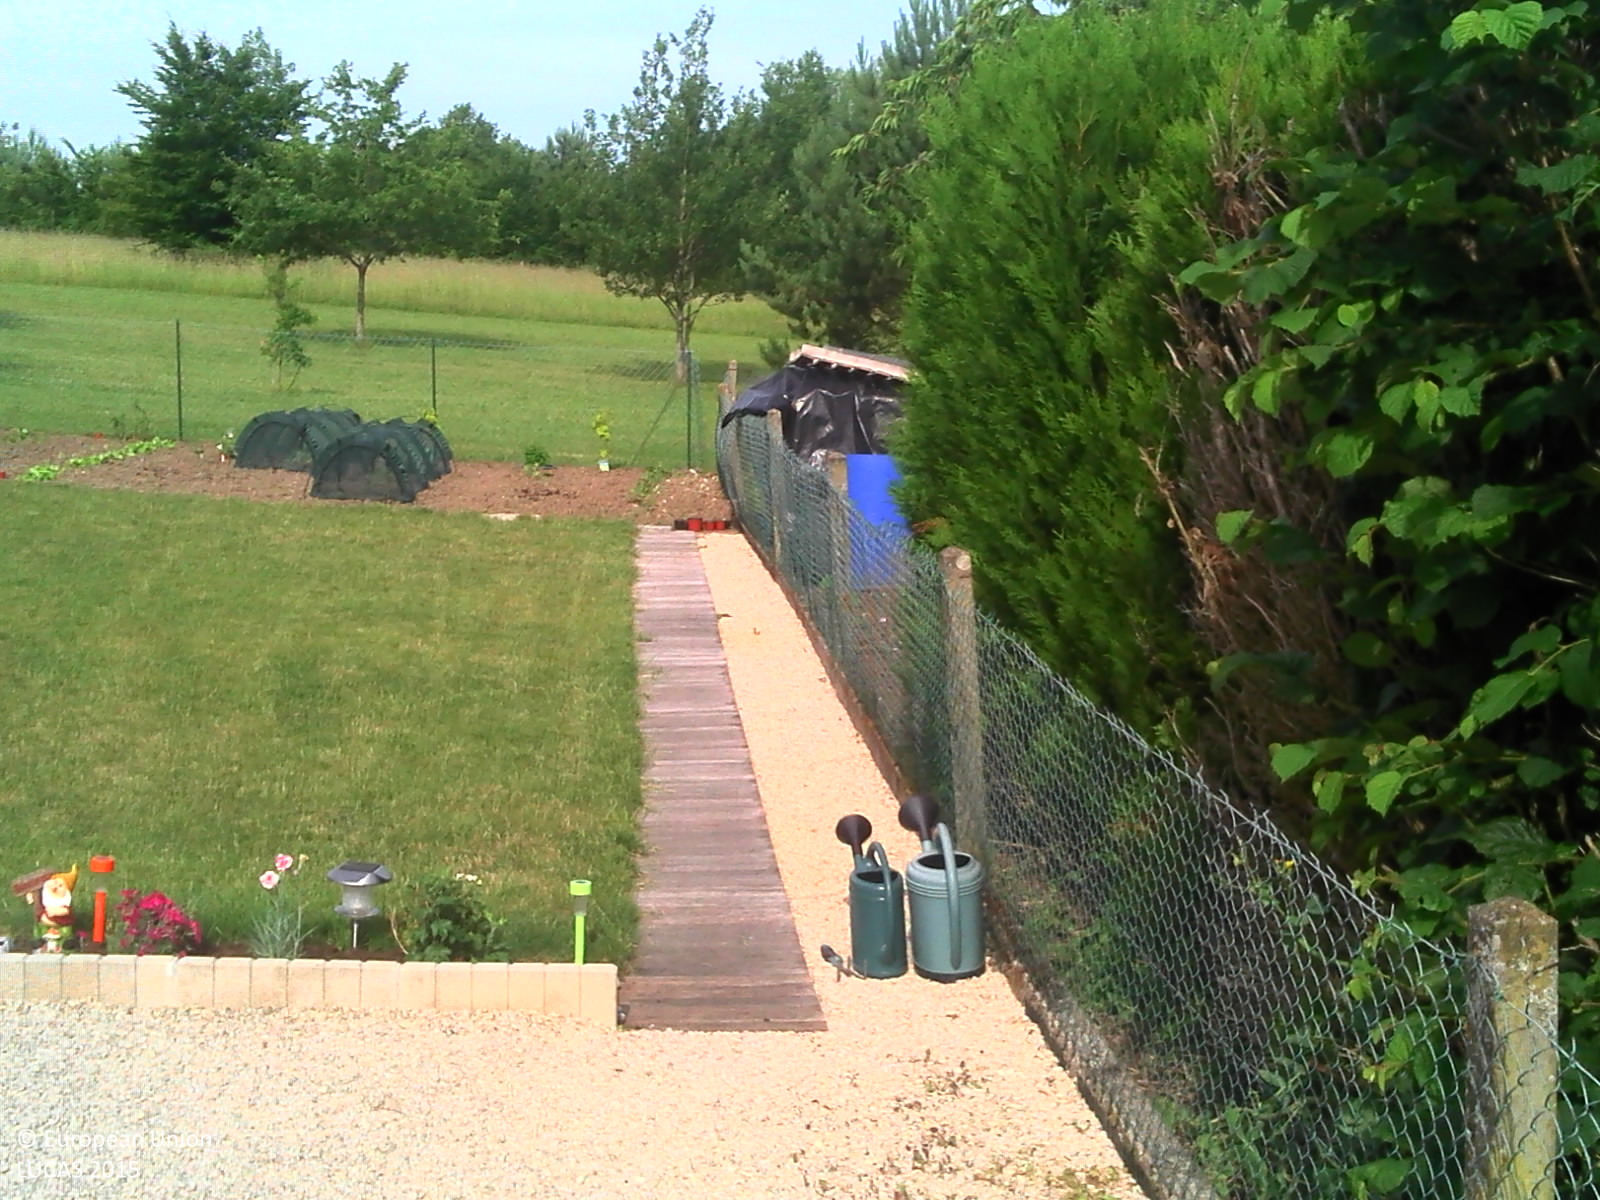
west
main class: Grassland
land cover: Grassland with sparse tree/shrub cover
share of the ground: > 75 %
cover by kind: herbaceous plants 95 %, broadleaved forest trees 5 %
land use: Agriculture (excluding fallow land and kitchen gardens)
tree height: < 5 m
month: June
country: FR
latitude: 47.5265
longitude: 1.4187
